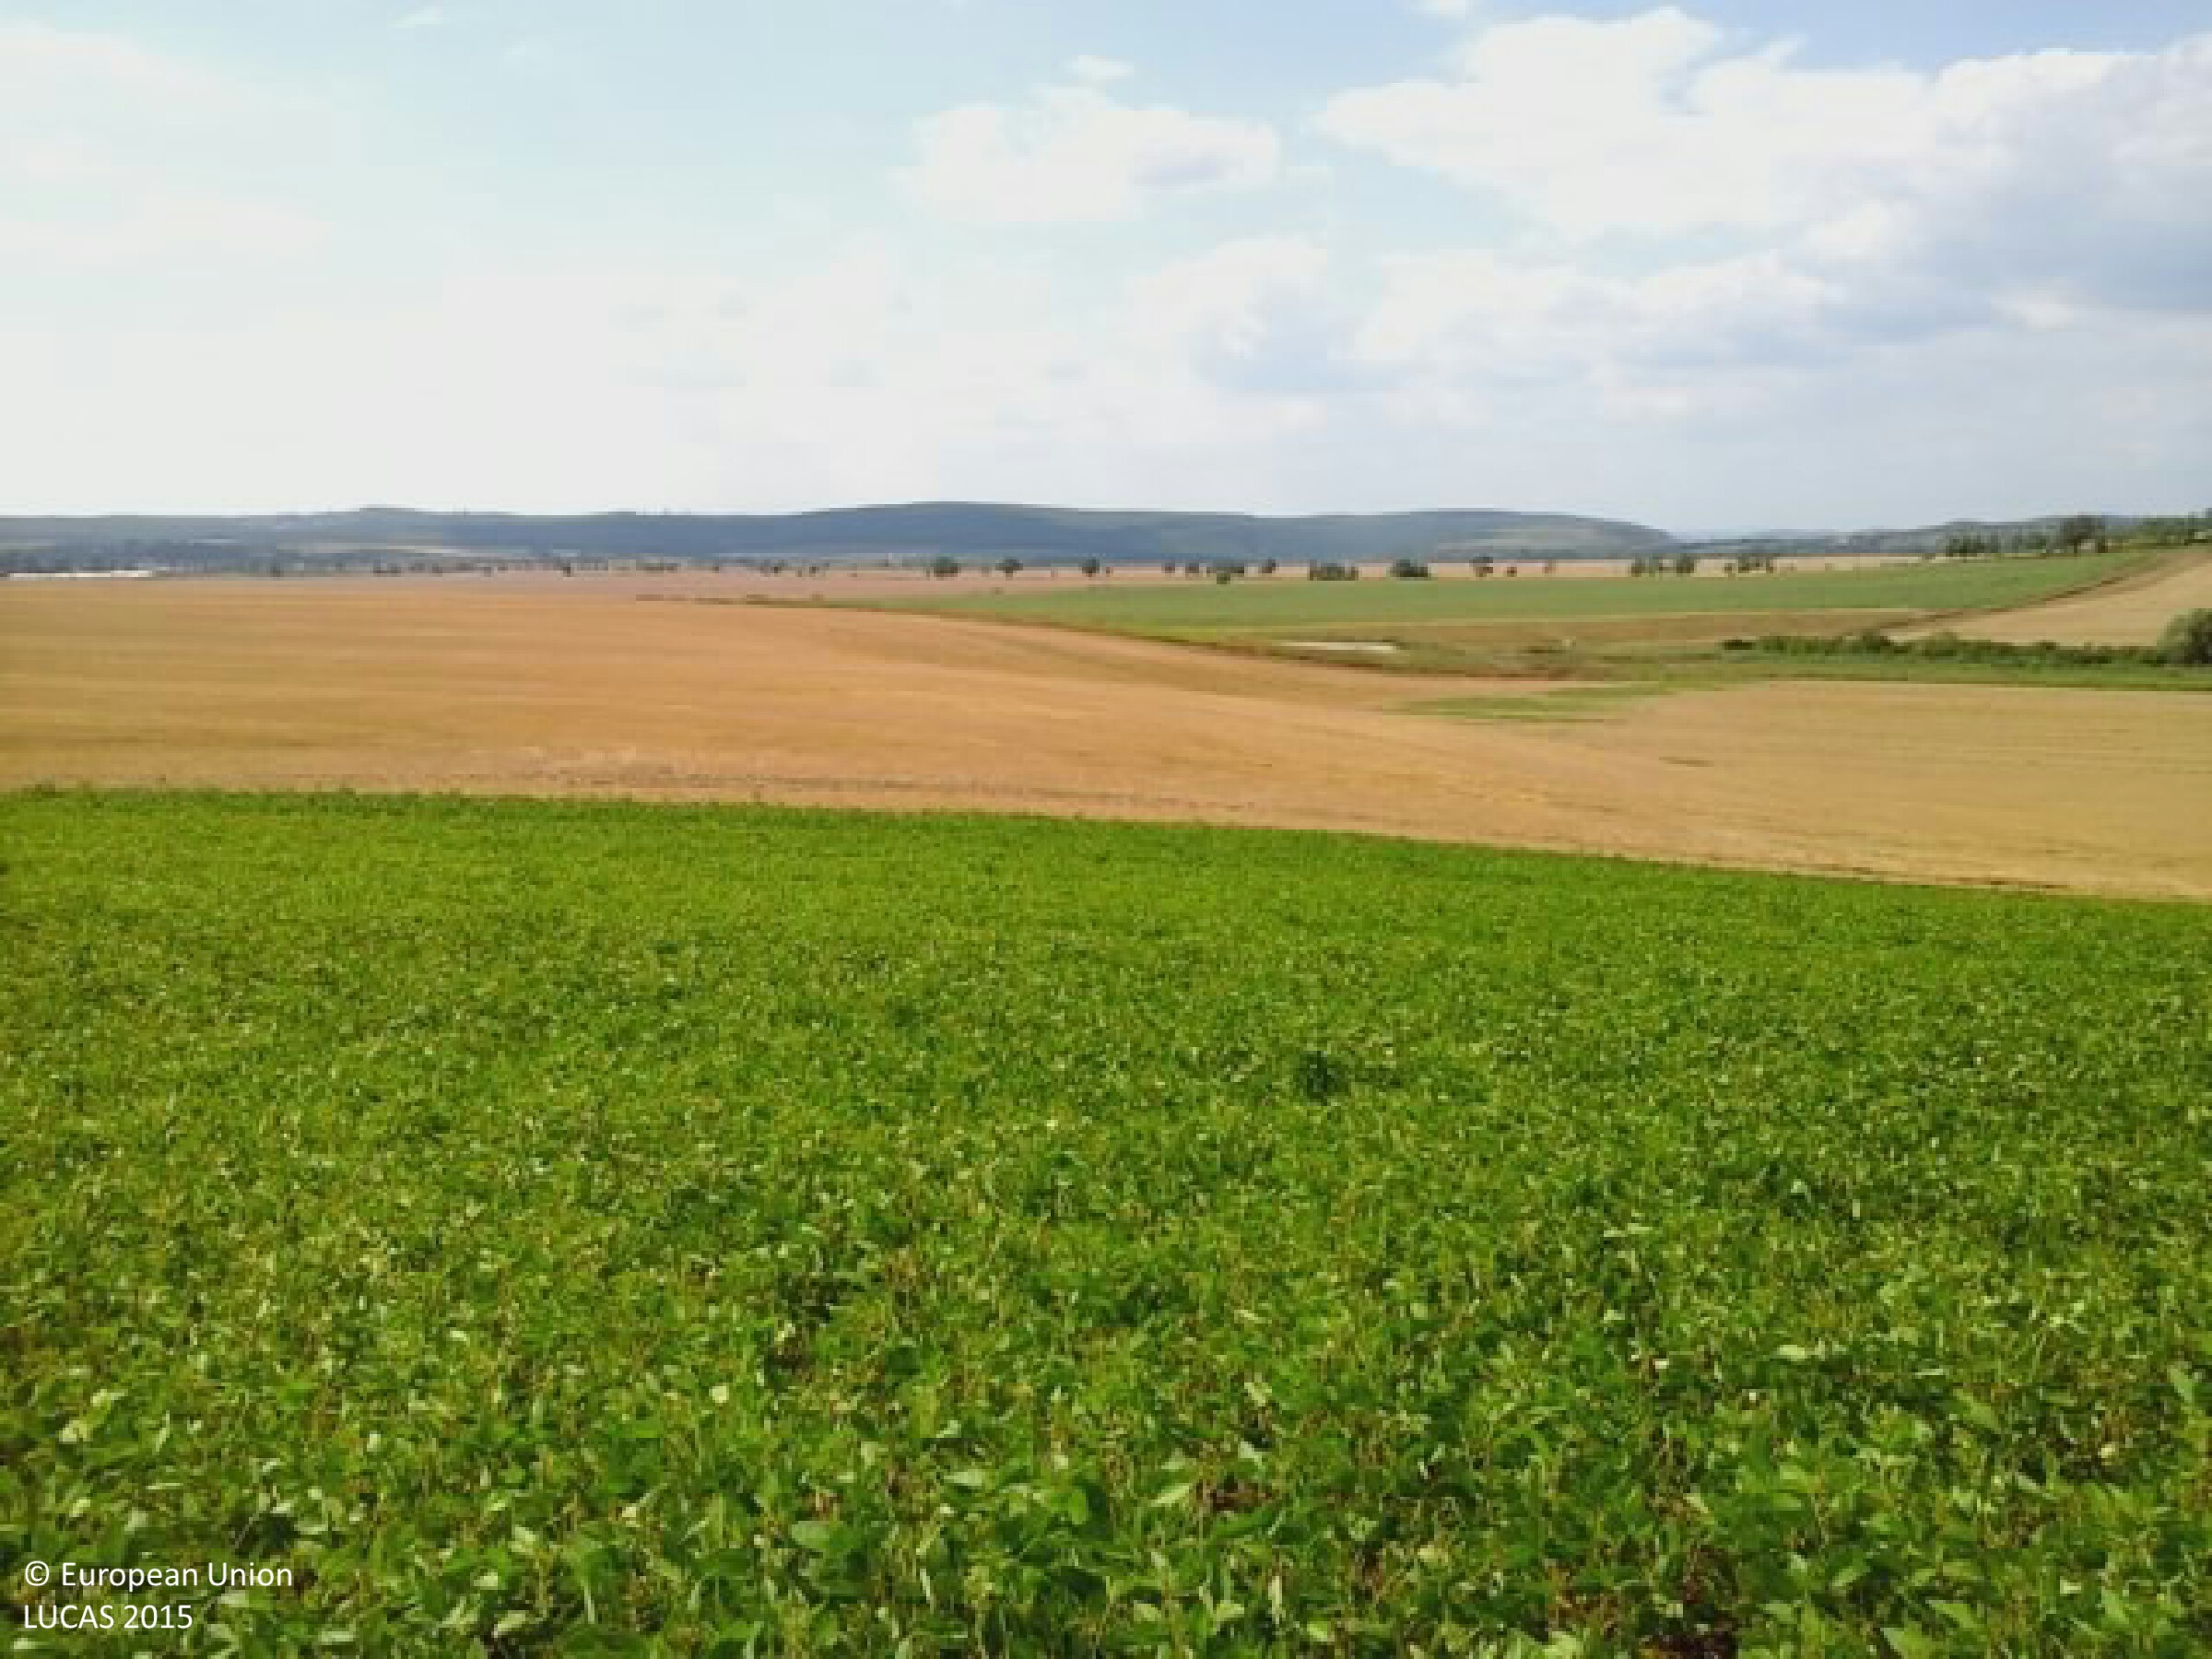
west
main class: Cropland
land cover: Soya
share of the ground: > 75 %
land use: Agriculture (excluding fallow land and kitchen gardens)
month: July
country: HU
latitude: 48.2923
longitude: 20.7799
